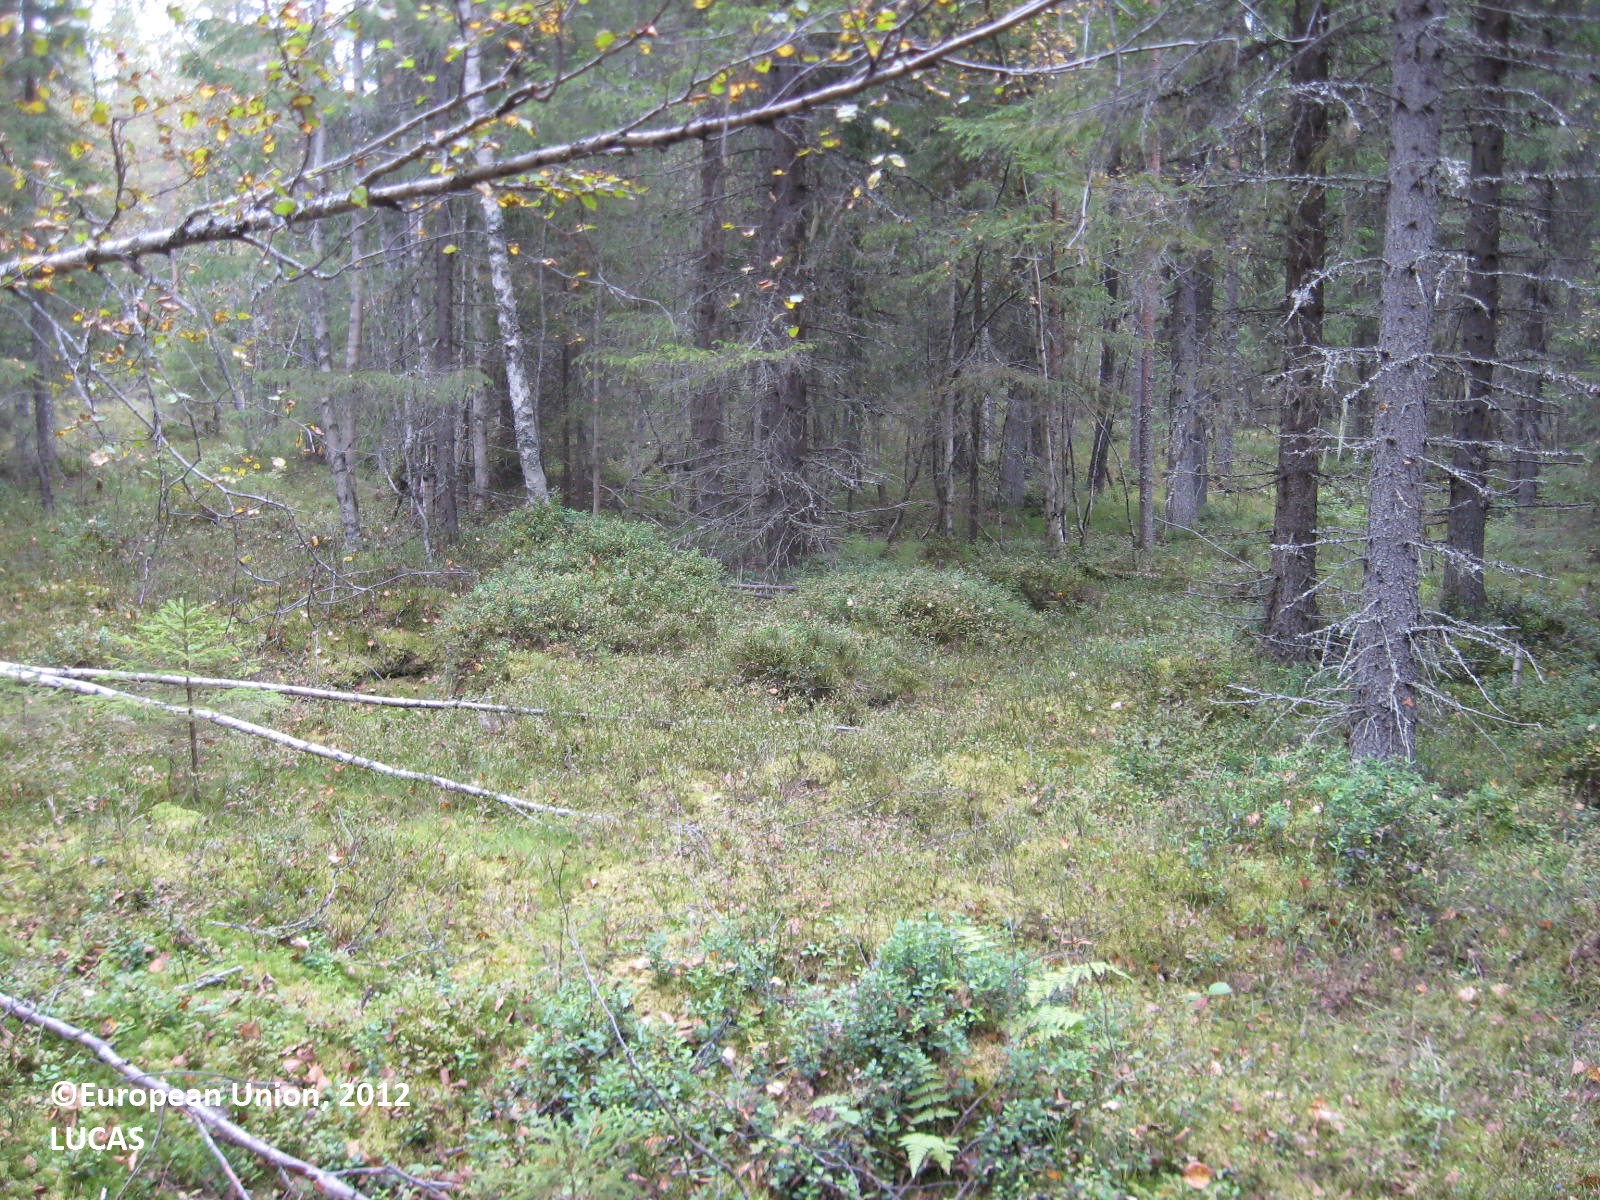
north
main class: Woodland
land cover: Spruce dominated mixed woodland
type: boreal forest
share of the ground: > 75 %
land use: Forestry
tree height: > 5 m
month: August
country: FI
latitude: 63.9313
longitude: 29.2405
